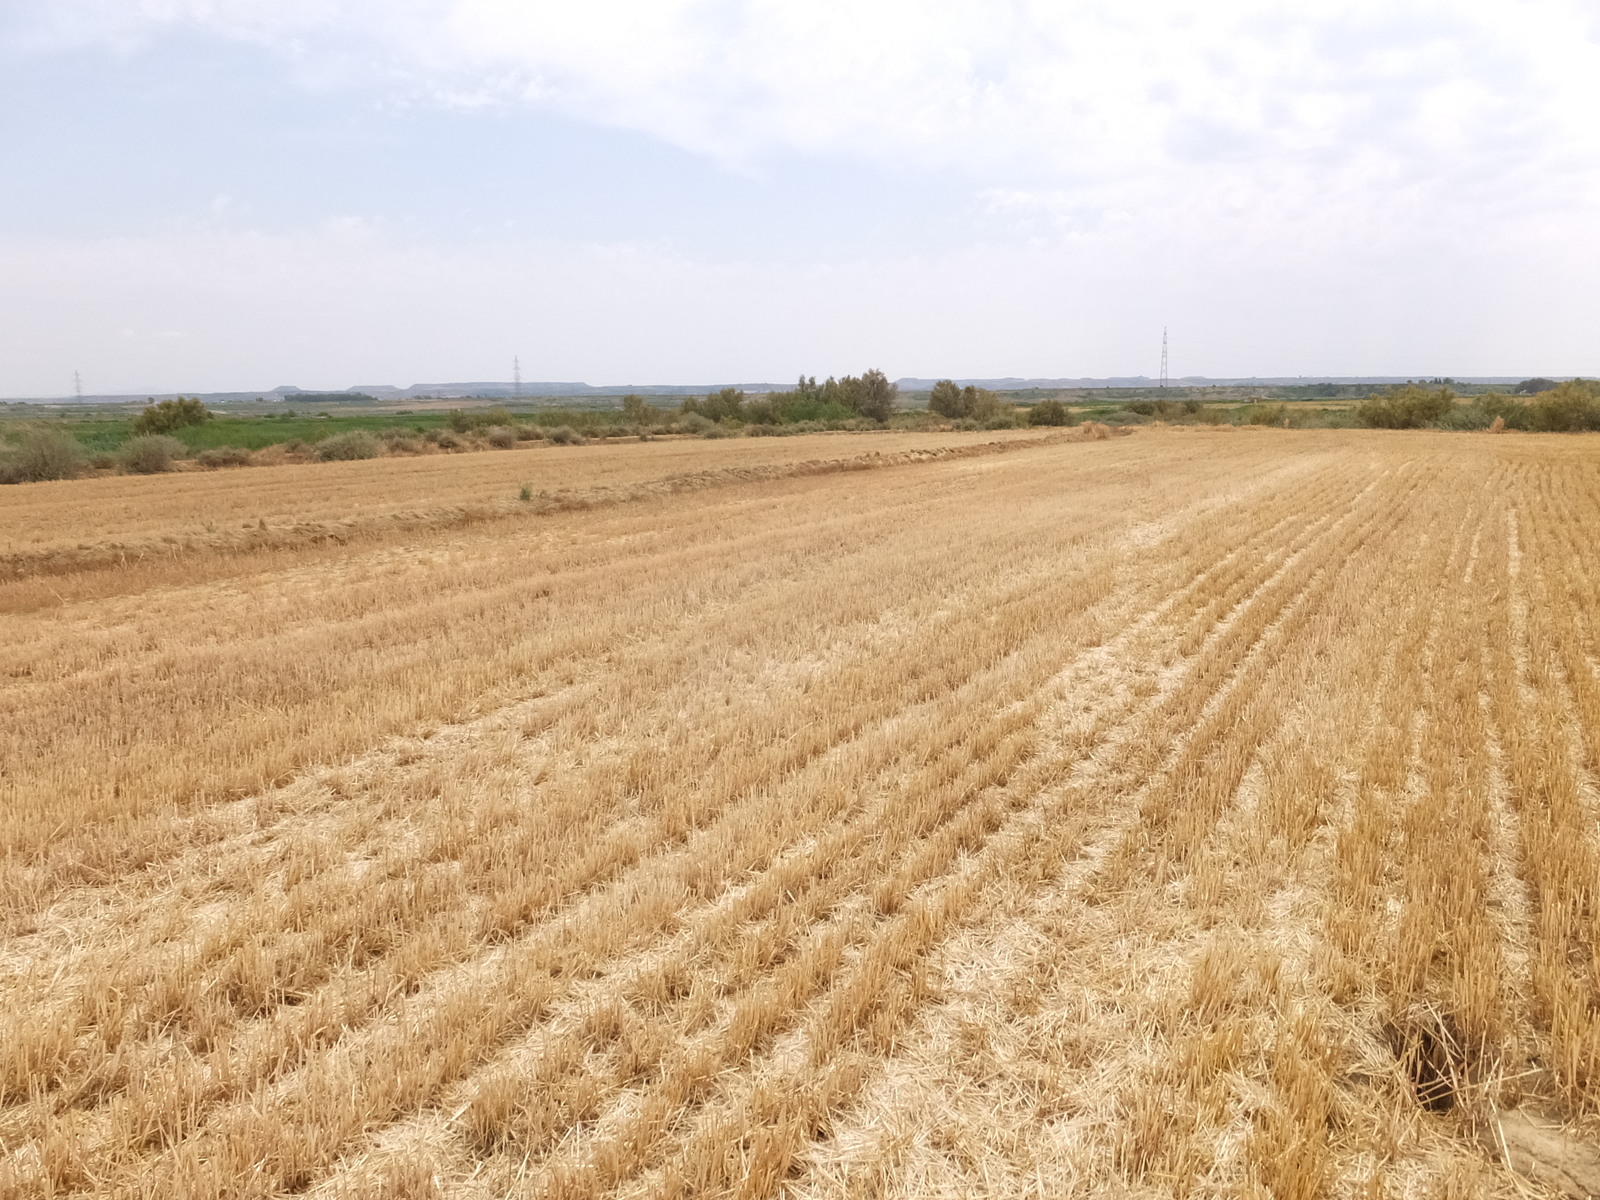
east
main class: Cropland
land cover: Barley
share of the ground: < 10 %
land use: Agriculture (excluding fallow land and kitchen gardens)
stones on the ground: < 10 %
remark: Harvested field
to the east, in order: Barley; Grass margins; Barley; Grass margins; Rivers and streams; Shrubland without tree cover; Rivers and streams; Shrubland with sparse tree cover; Other bare soil; Shrubland with sparse tree cover; Grass margins; Tracks; Other bare soil; Grass margins; Other bare soil; Grass margins; Other bare soil
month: June
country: ES
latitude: 41.7662
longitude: 0.0839
